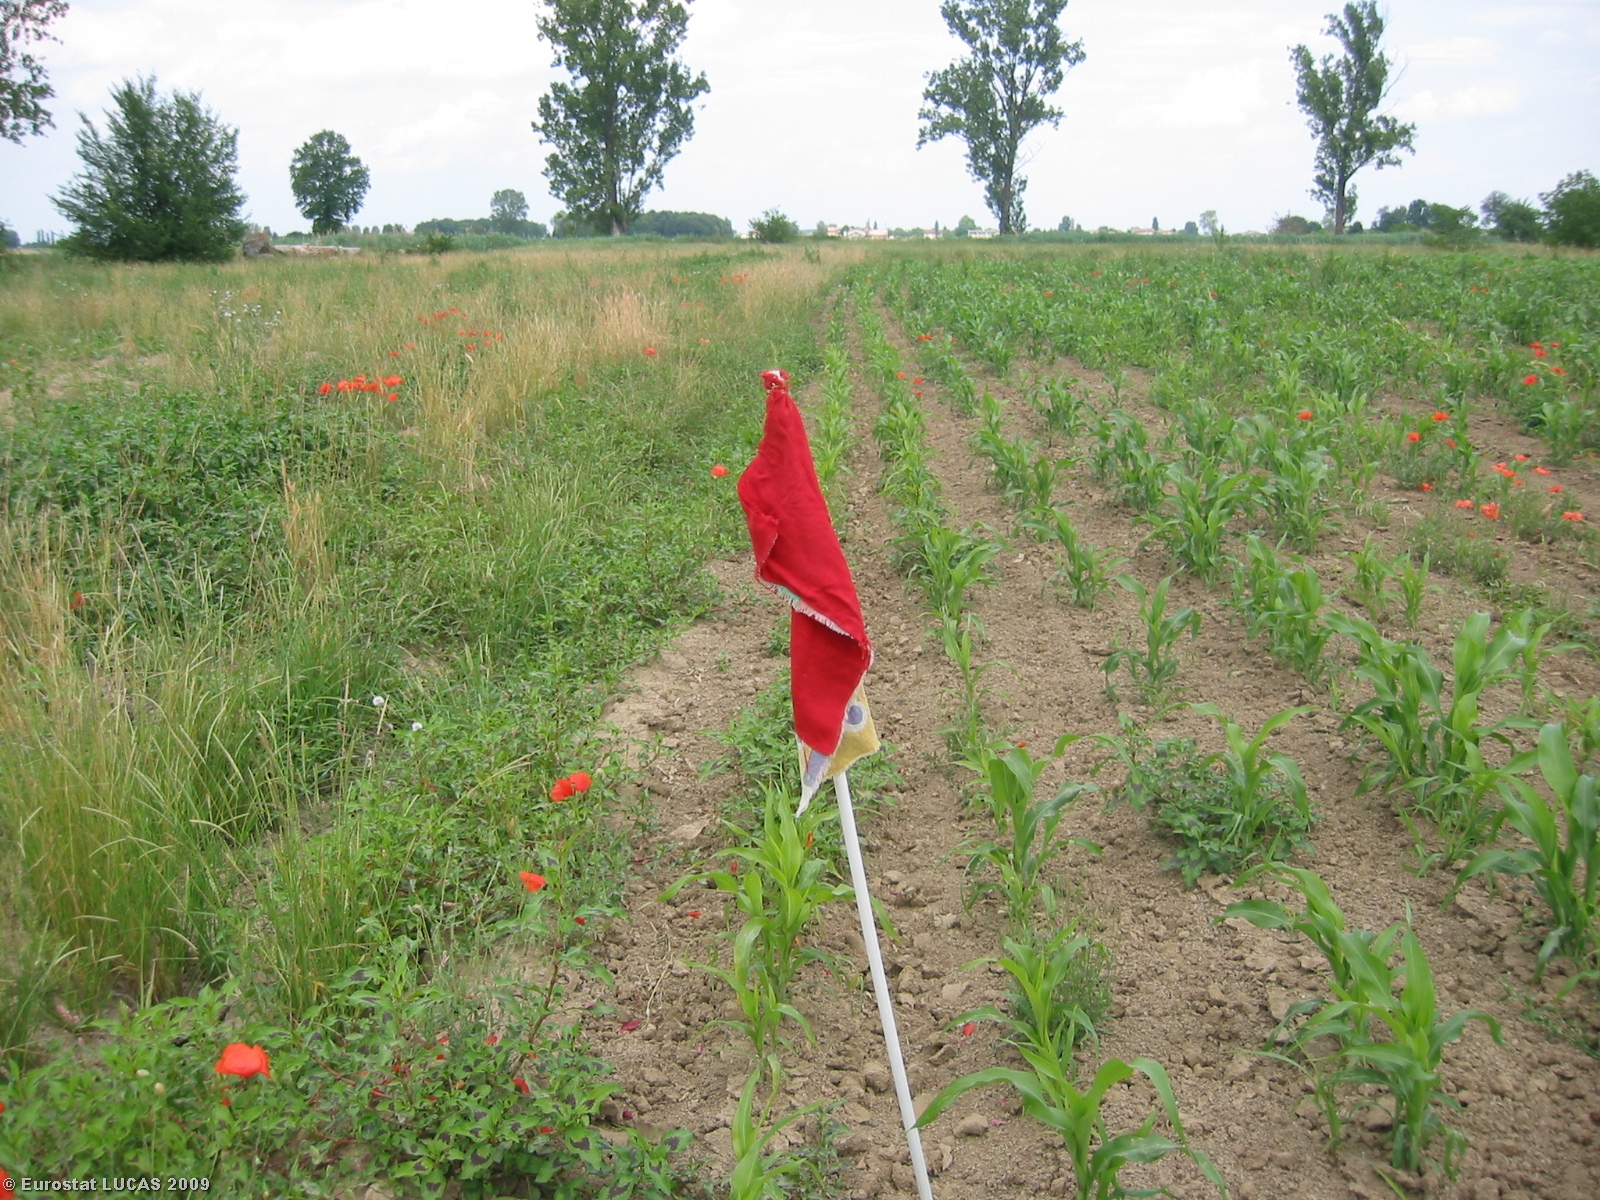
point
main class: Cropland
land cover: Other cereals
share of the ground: 25 - 50 %
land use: Agriculture (excluding fallow land and kitchen gardens)
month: June
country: IT
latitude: 44.8359
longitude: 10.5681
